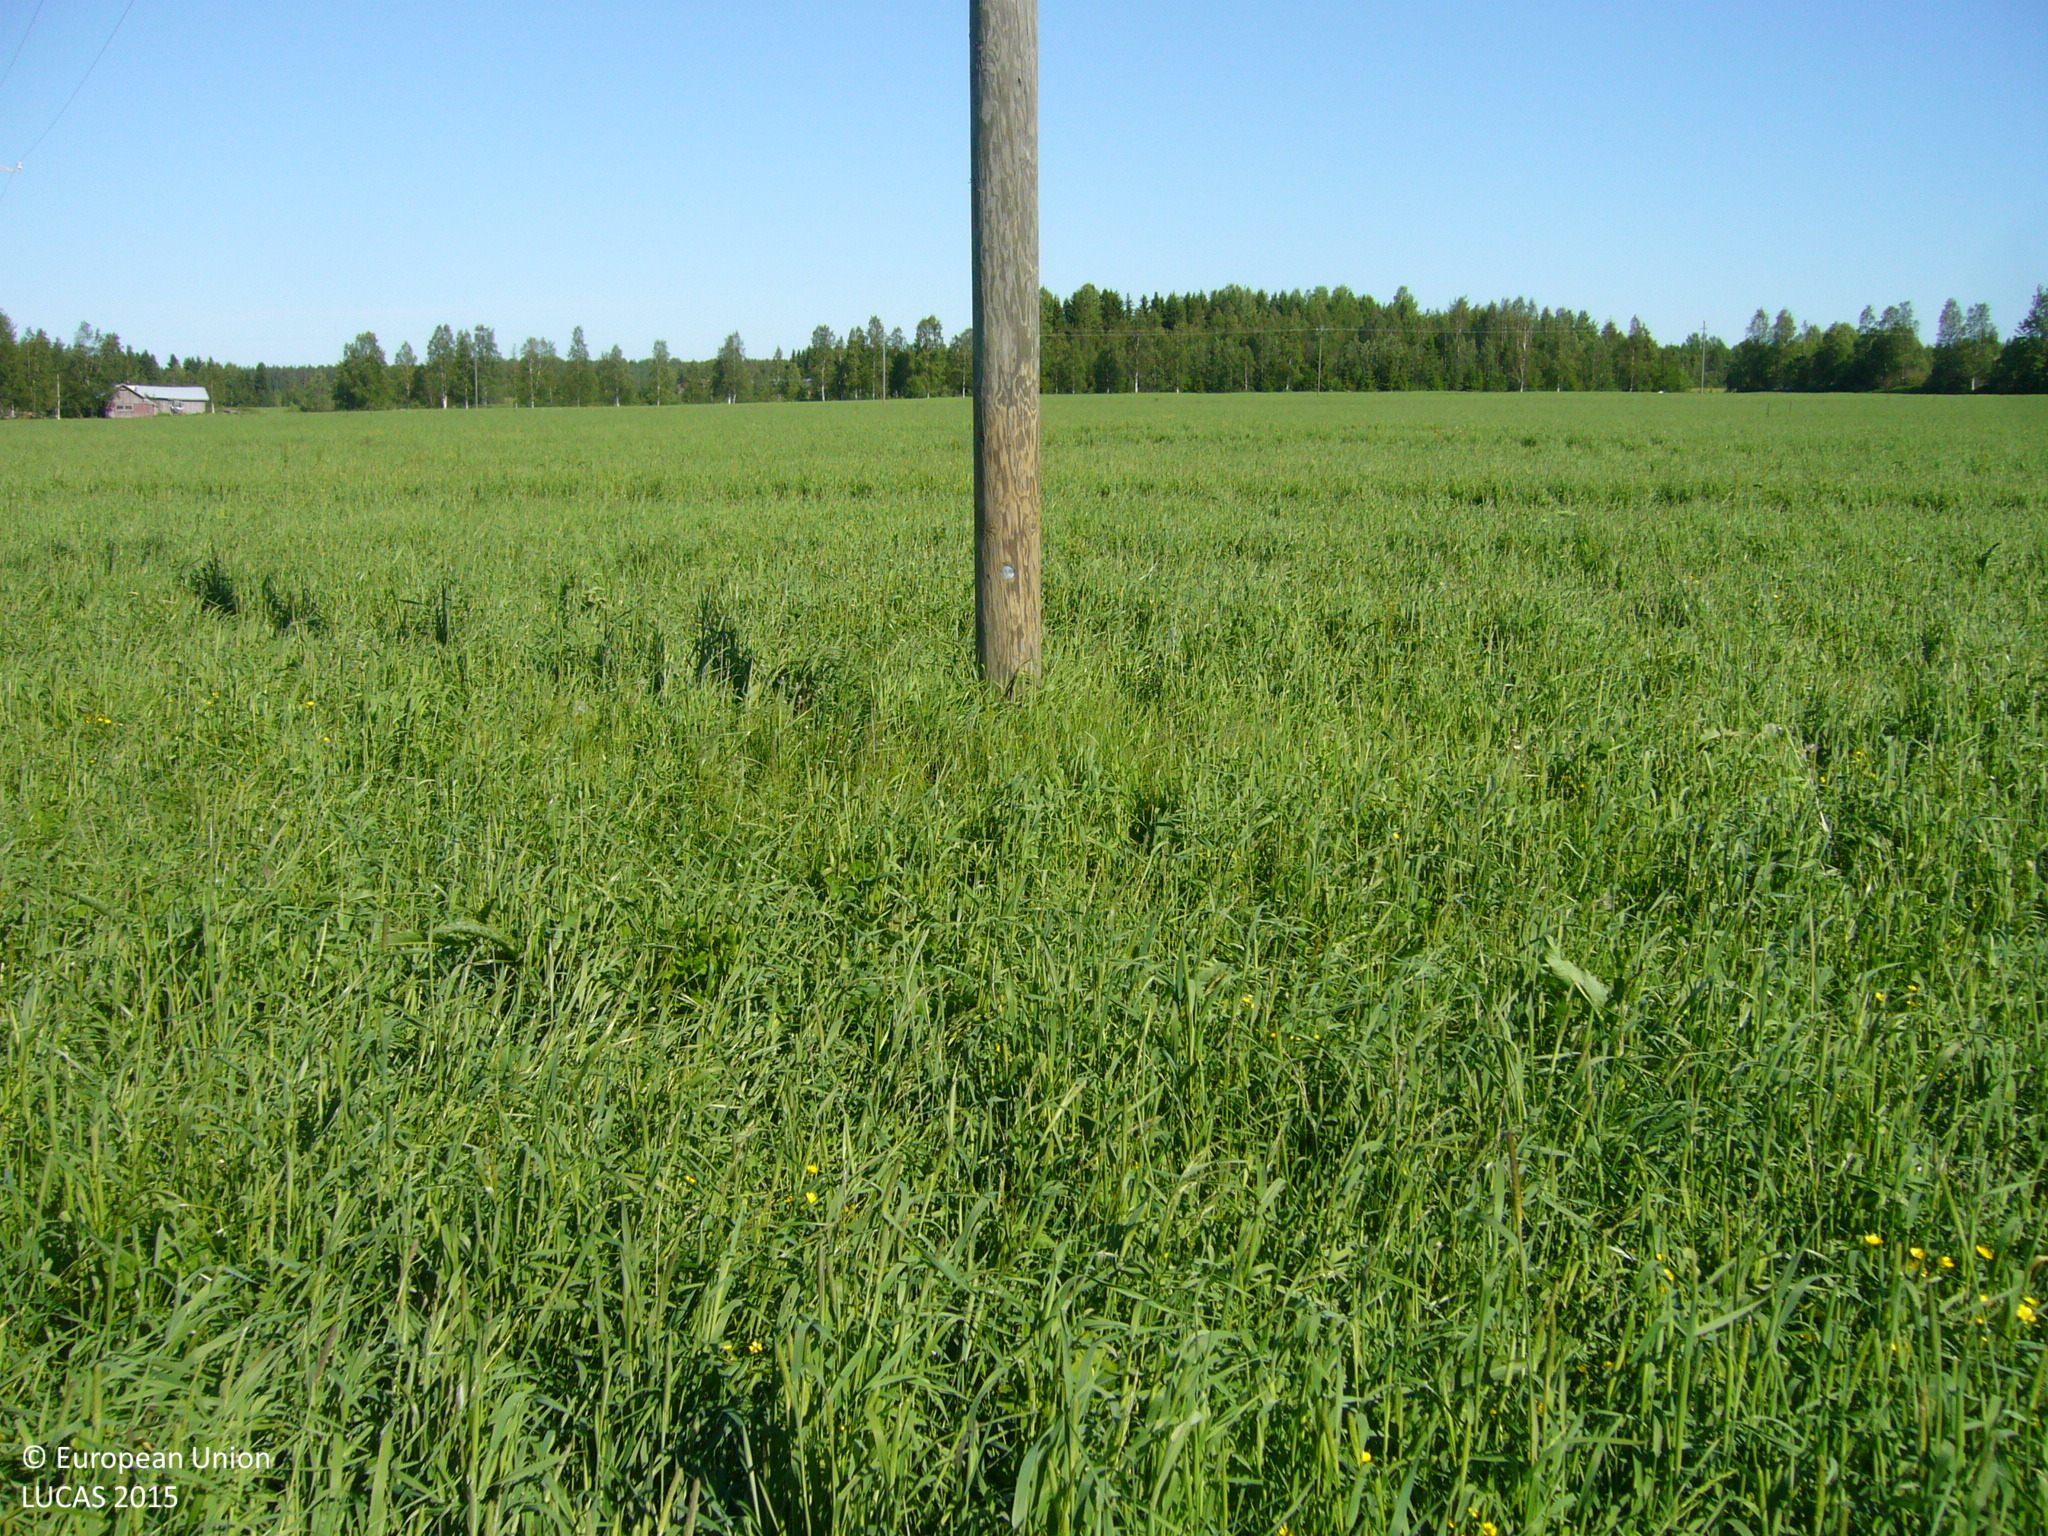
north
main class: Cropland
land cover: Temporary grasslands
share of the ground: > 75 %
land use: Agriculture (excluding fallow land and kitchen gardens)
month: June
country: FI
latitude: 63.8631
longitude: 26.4595
